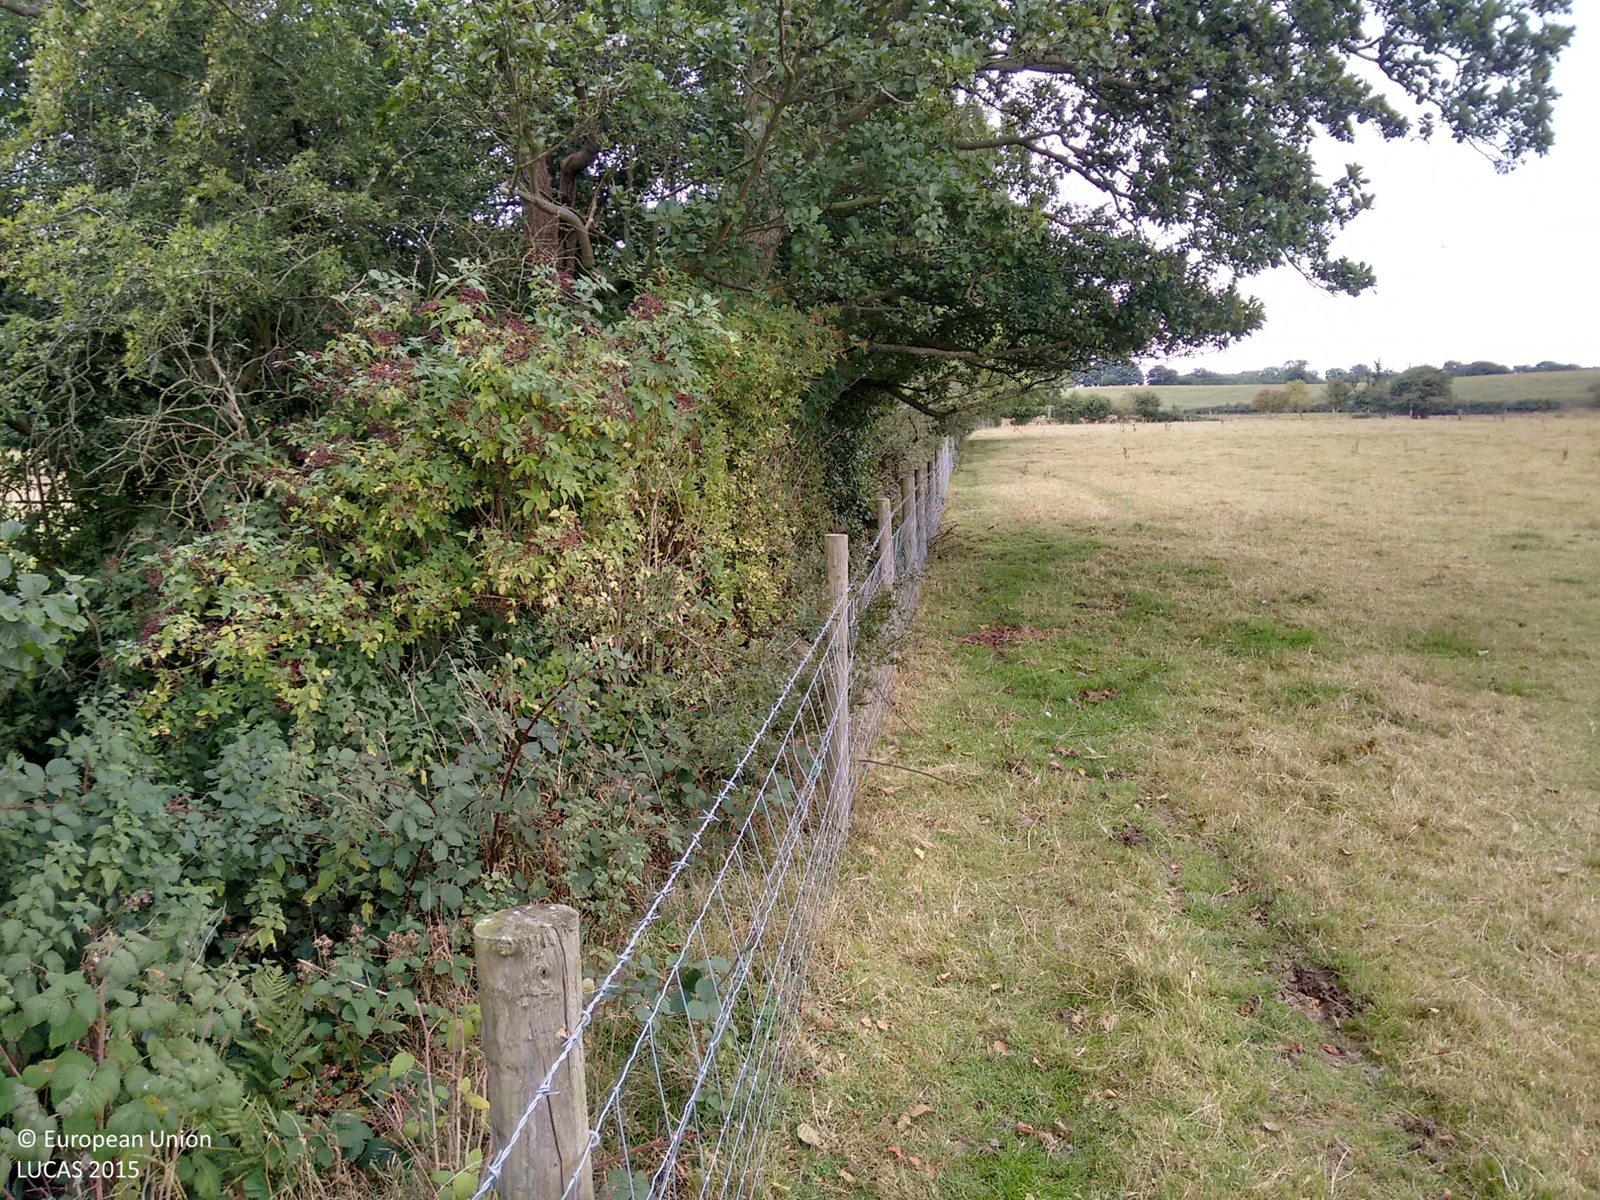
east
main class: Grassland
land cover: Grassland without tree/shrub cover
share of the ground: > 75 %
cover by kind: herbaceous plants 100 %
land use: Agriculture (excluding fallow land and kitchen gardens)
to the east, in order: Grassland without tree/shrub cover; Fences; Broadleaved woodland; Grassland without tree/shrub cover
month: September
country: GB
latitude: 52.8953
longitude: -3.0222
